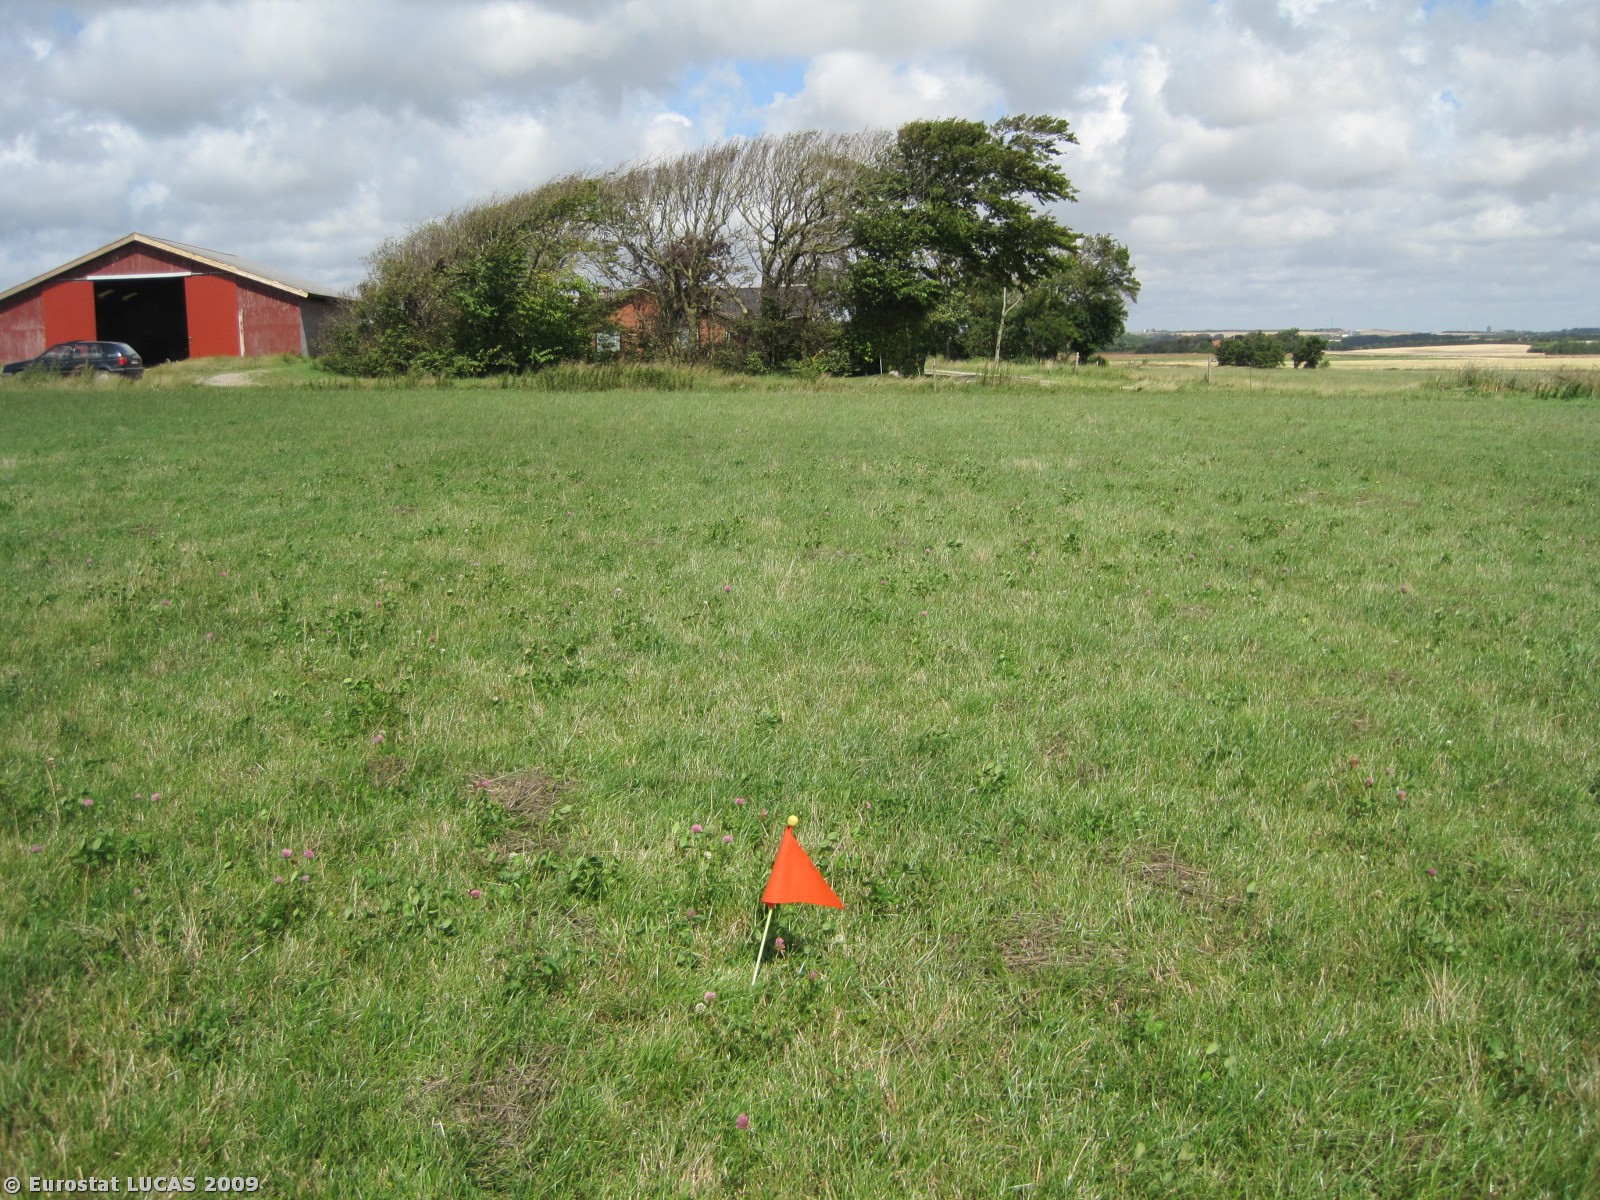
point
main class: Grassland
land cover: Grassland without tree/shrub cover
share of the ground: > 75 %
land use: Agriculture (excluding fallow land and kitchen gardens)
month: July
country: DK
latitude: 56.8252
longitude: 8.4127
